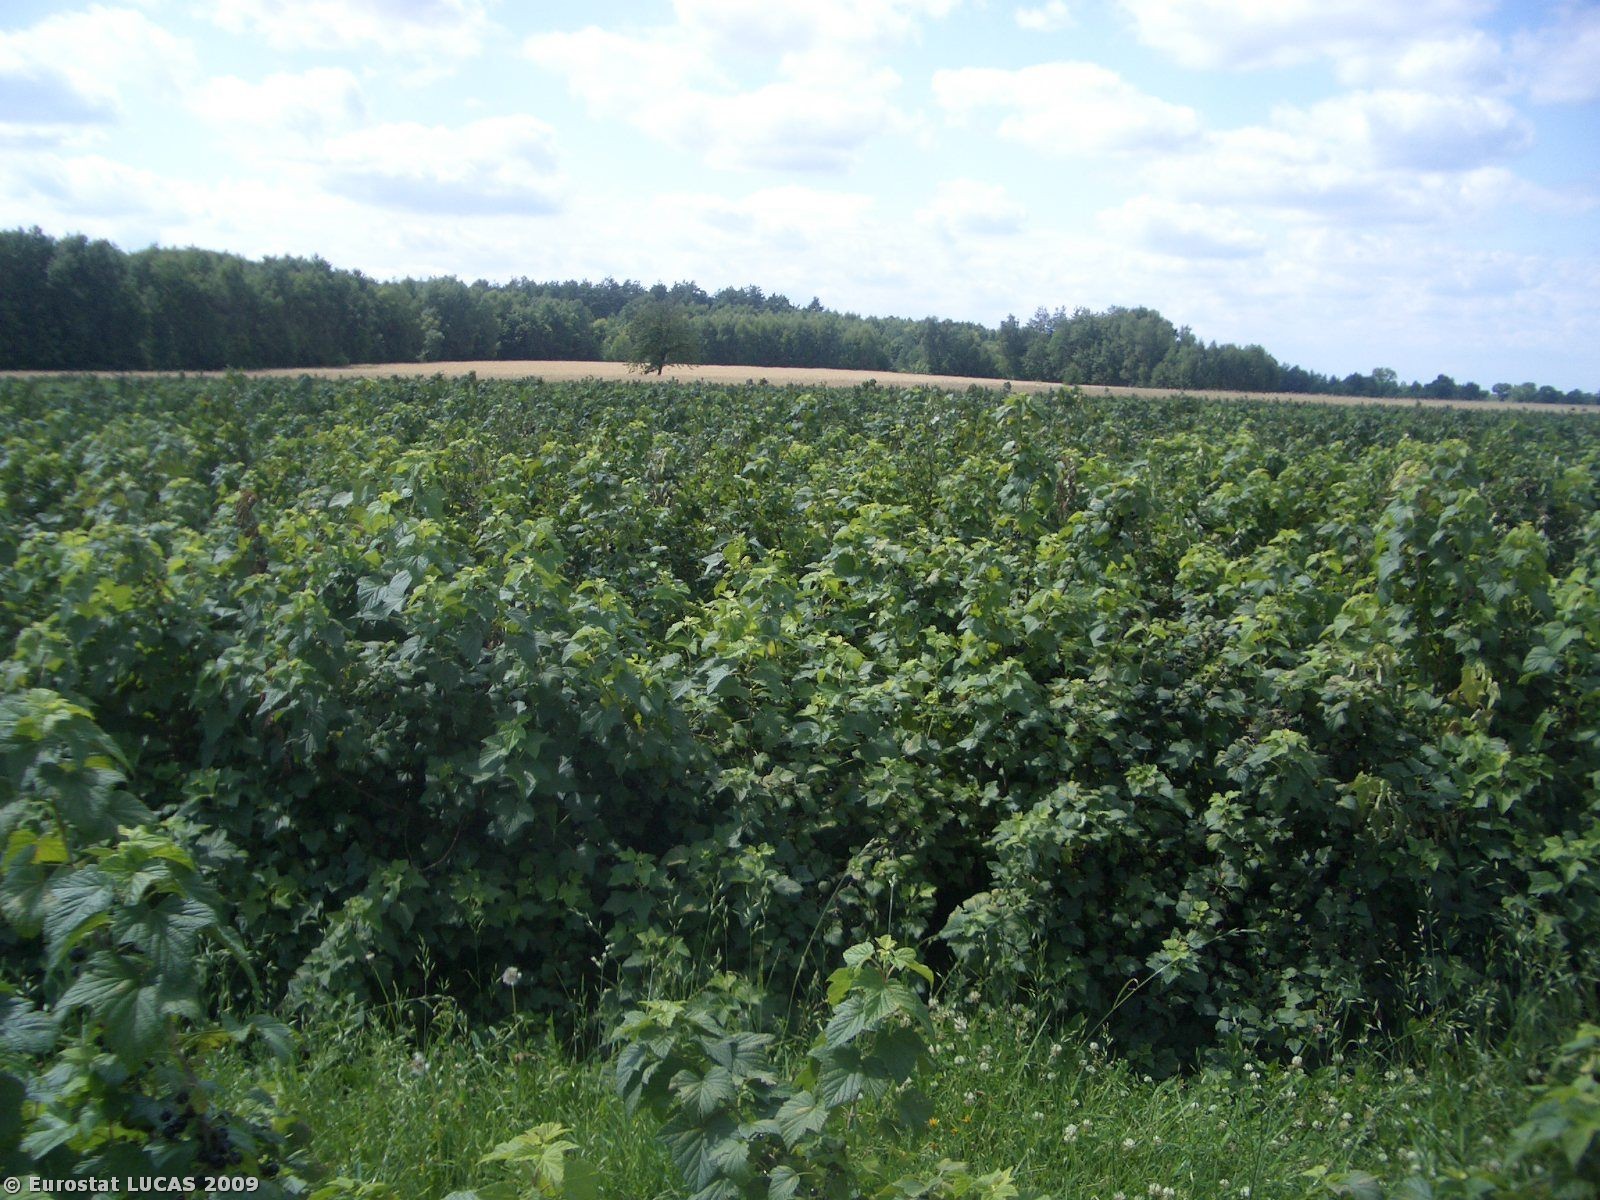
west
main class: Cropland
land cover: Other fruit trees and berries
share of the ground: 25 - 50 %
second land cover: Grassland with sparse tree/shrub cover
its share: 25 - 50 %
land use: Agriculture (excluding fallow land and kitchen gardens)
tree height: < 5 m
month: July
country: PL
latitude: 52.1817
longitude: 23.0485
